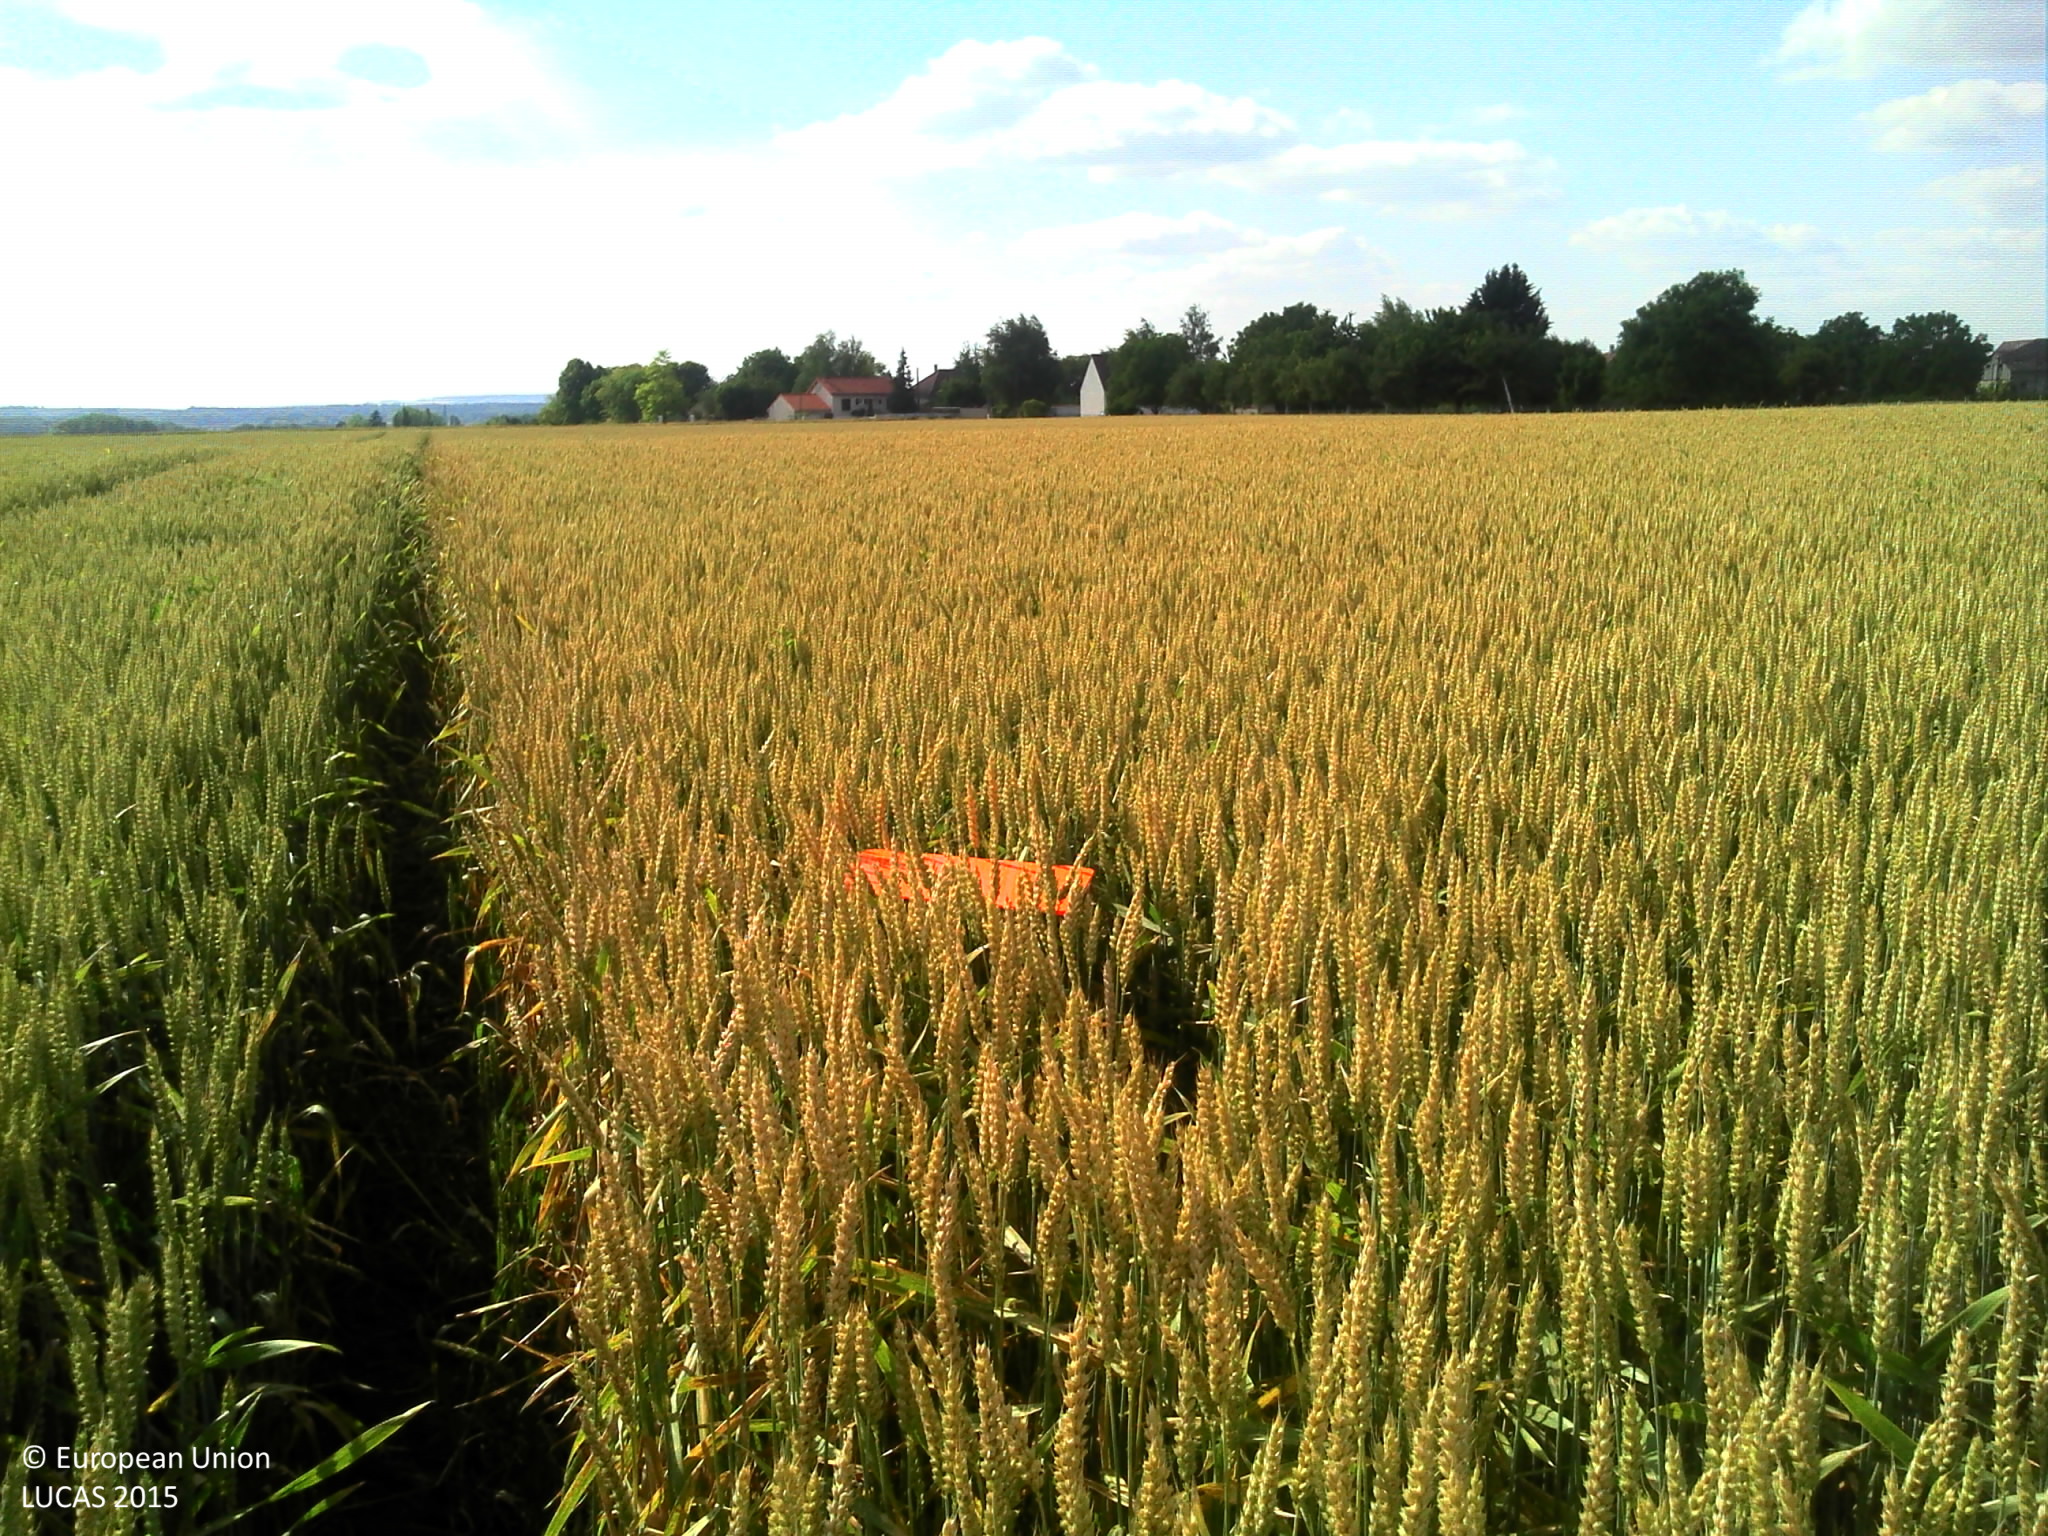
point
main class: Cropland
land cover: Common wheat
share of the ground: > 75 %
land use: Agriculture (excluding fallow land and kitchen gardens)
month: June
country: FR
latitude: 46.7495
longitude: 0.5703
